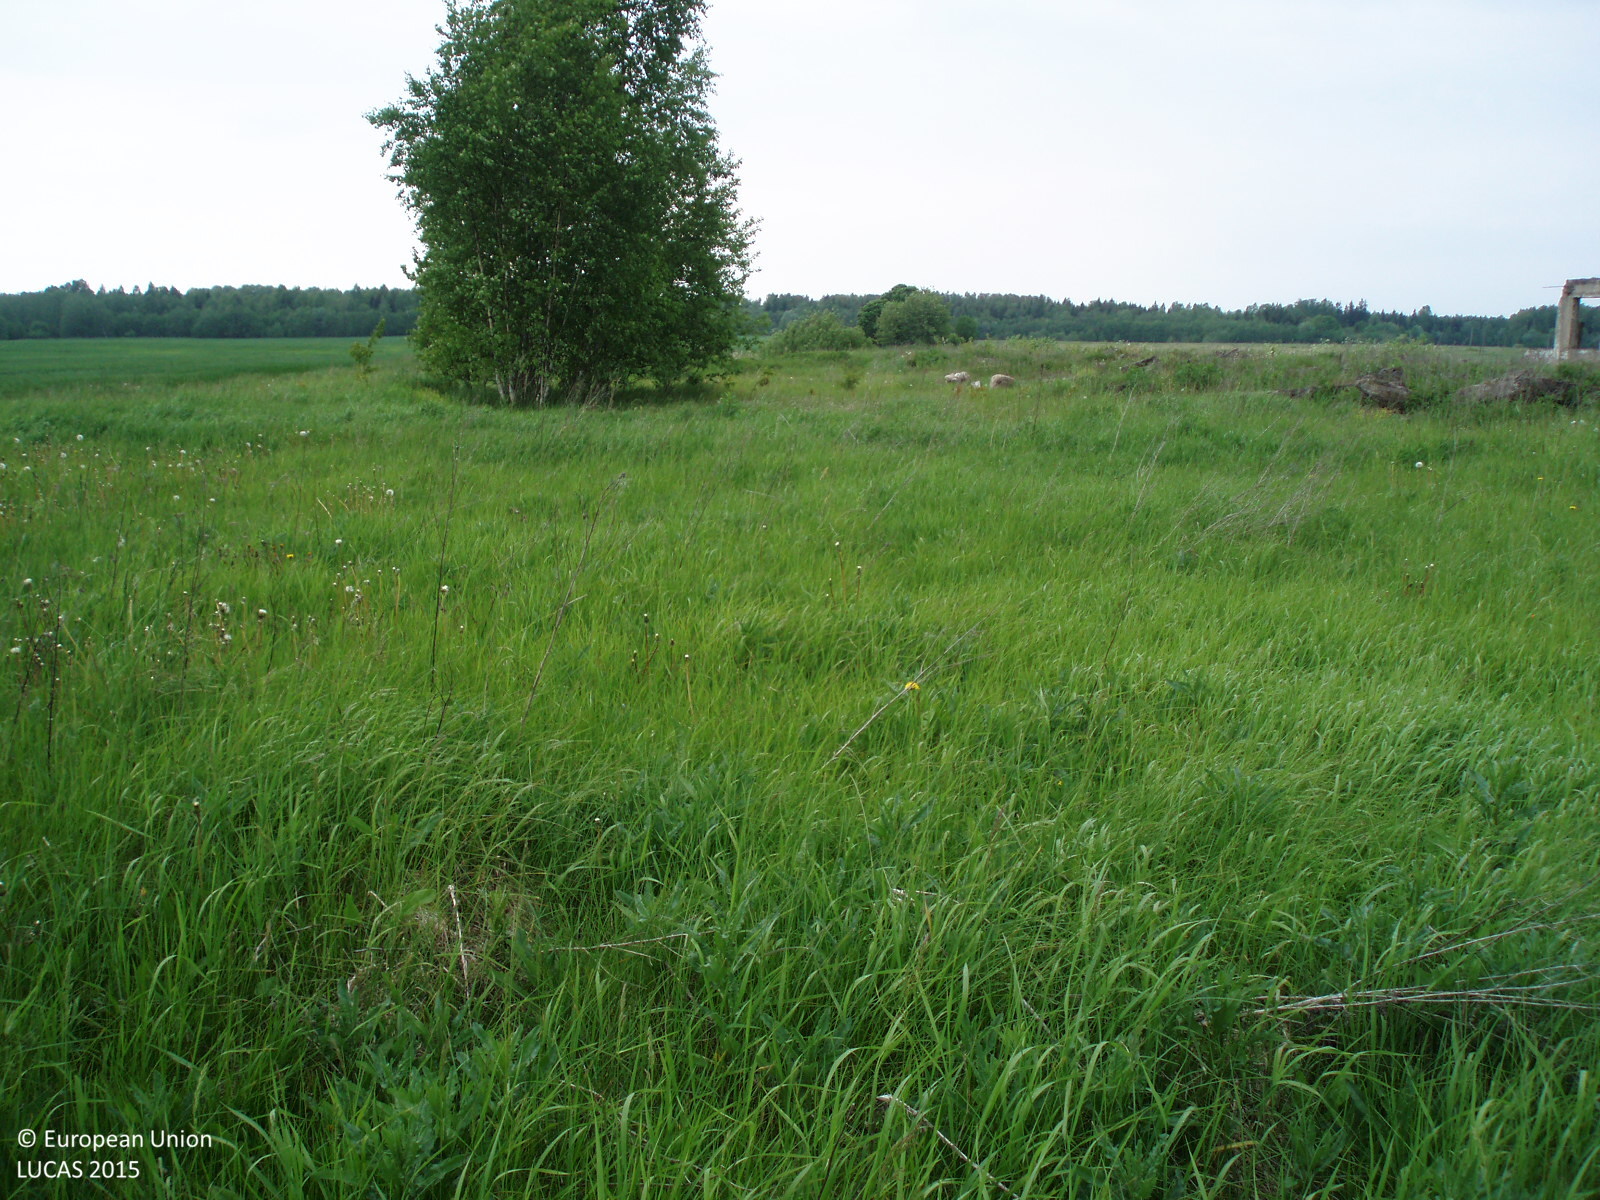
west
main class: Grassland
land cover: Grassland without tree/shrub cover
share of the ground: > 75 %
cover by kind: herbaceous plants 100 %
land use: Agriculture (excluding fallow land and kitchen gardens)
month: May
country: LT
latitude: 56.1177
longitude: 22.5241
